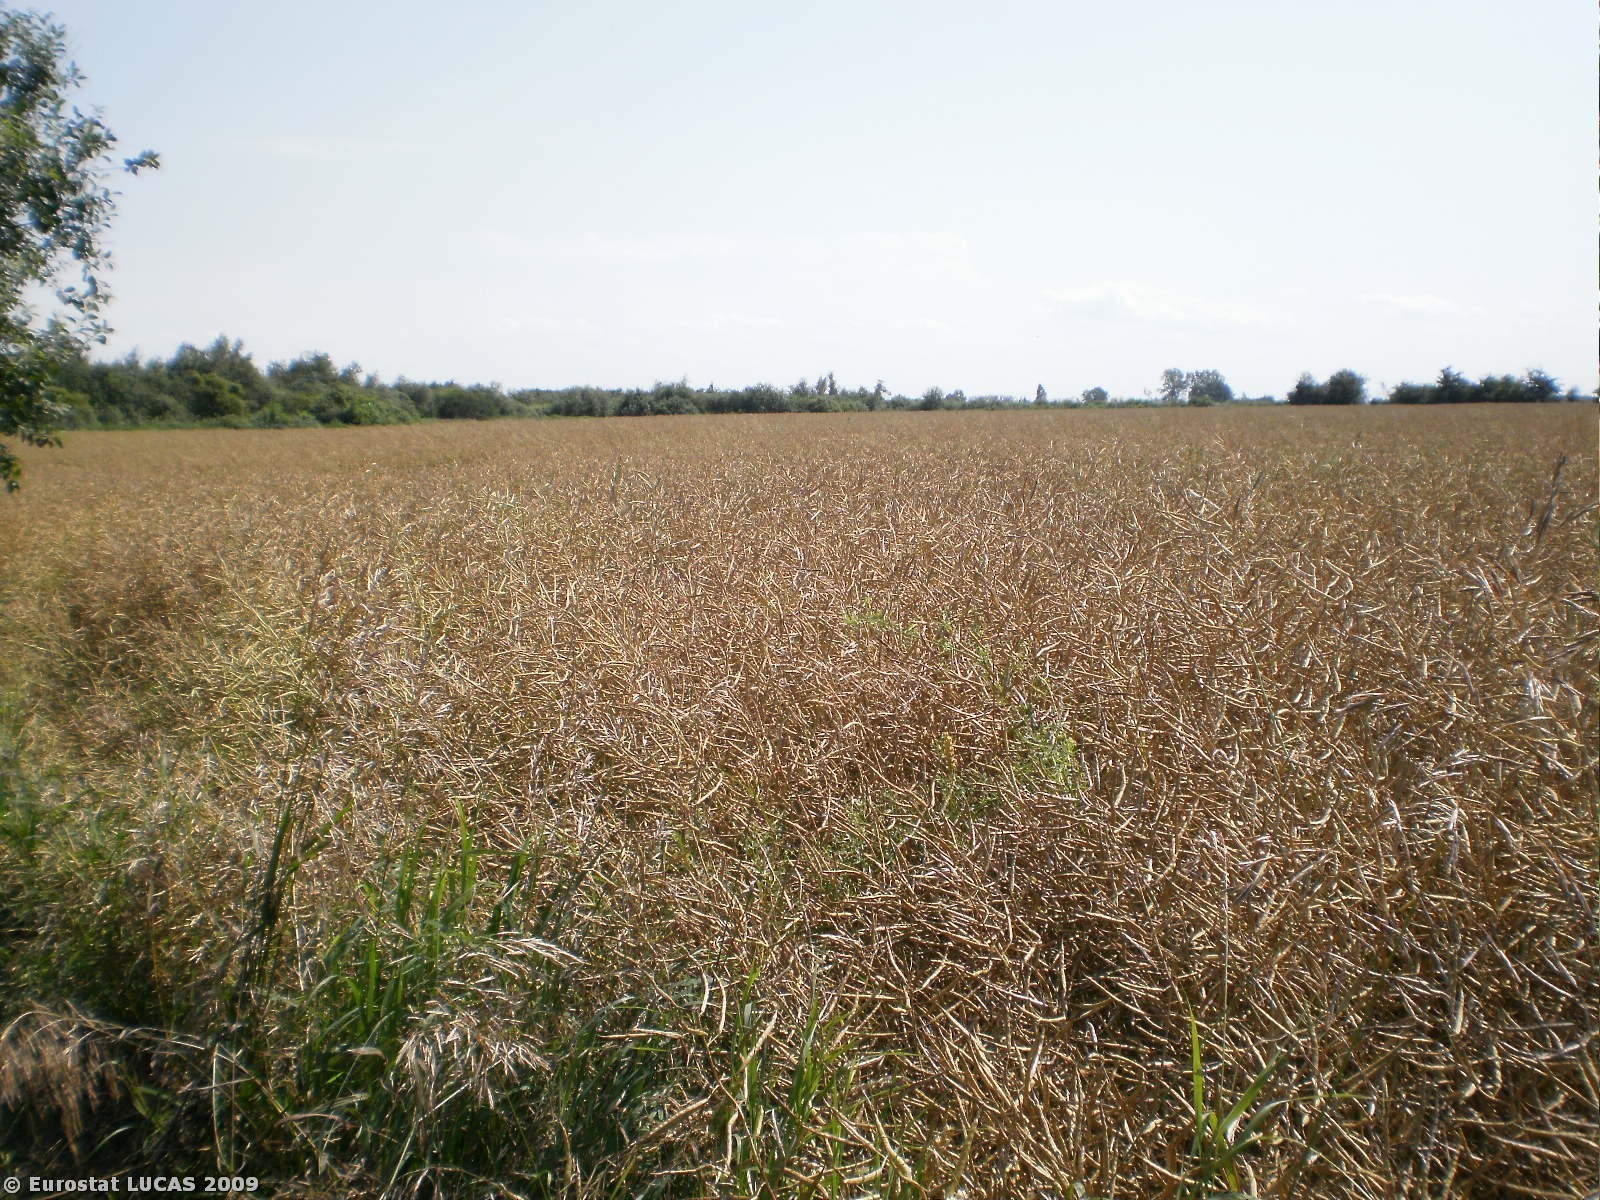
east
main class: Cropland
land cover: Rape and turnip rape
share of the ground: > 75 %
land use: Agriculture (excluding fallow land and kitchen gardens)
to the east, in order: Rape and turnip rape; Electric lines; Rape and turnip rape; Spontaneously vegetated surfaces; Broadleaved woodland
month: July
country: PL
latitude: 54.2296
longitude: 19.6454
